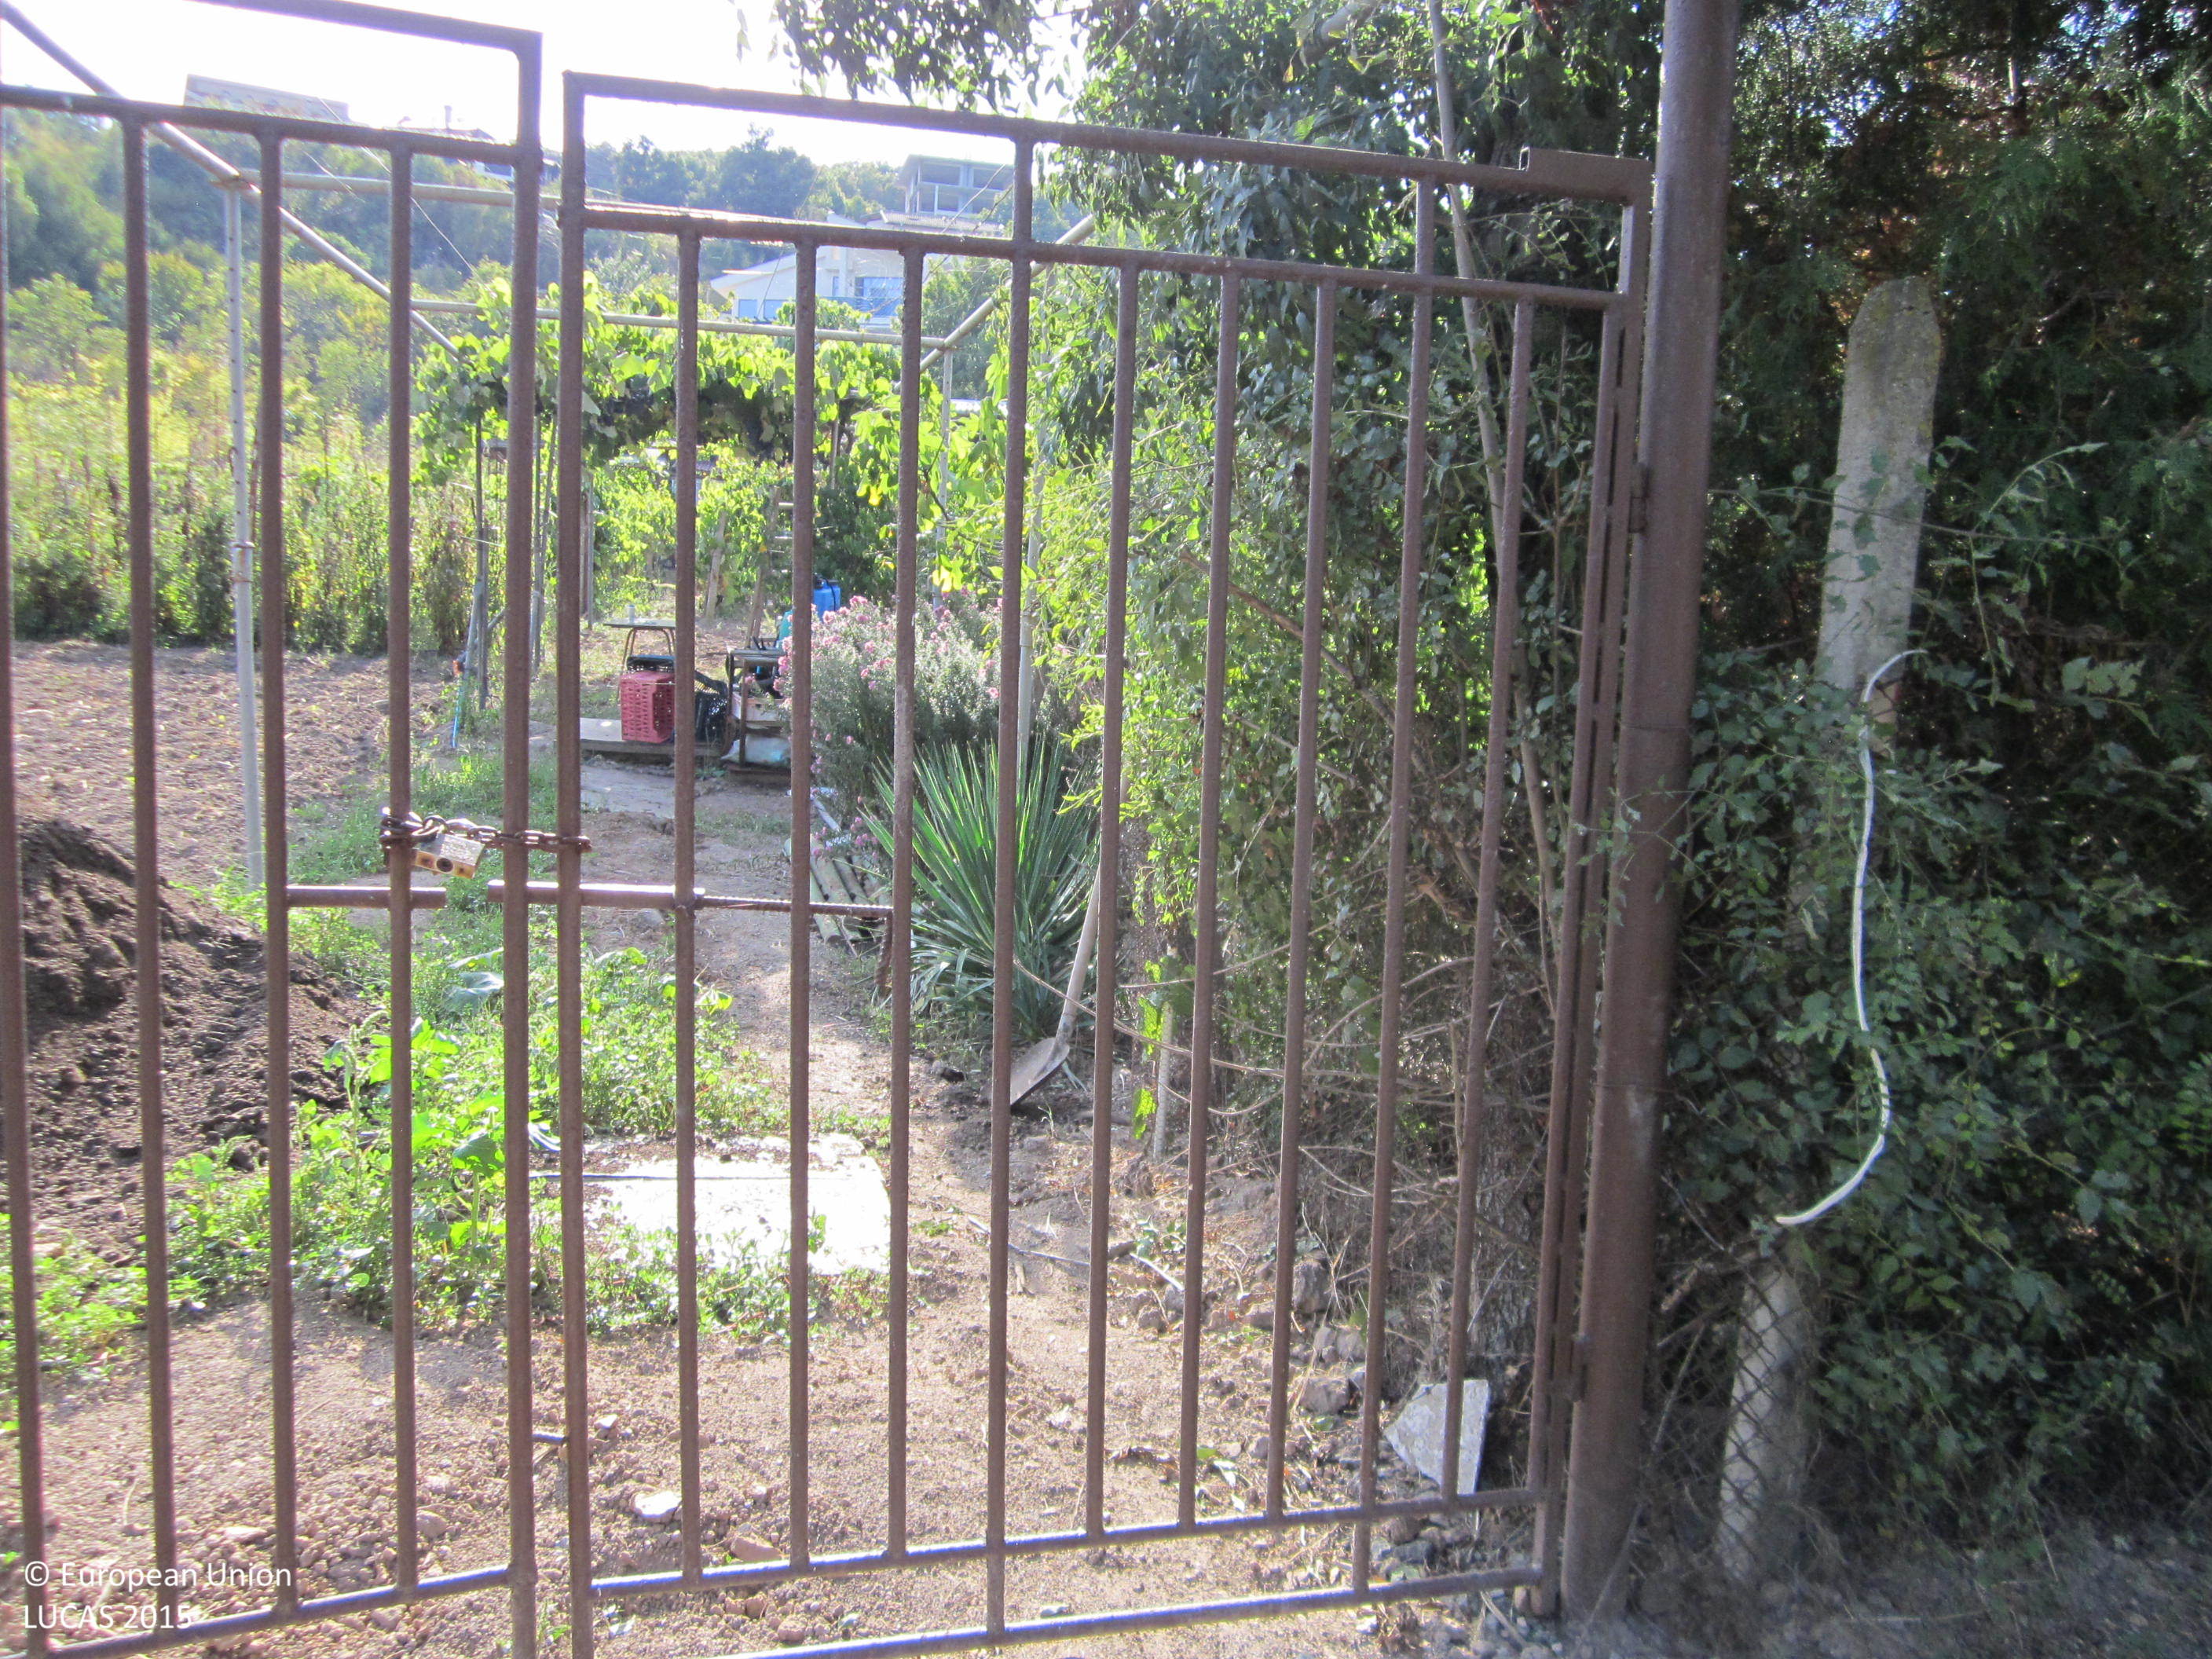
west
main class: Woodland
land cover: Broadleaved woodland
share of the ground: > 75 %
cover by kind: broadleaved forest trees 75 %, shrubs 20 %, herbaceous plants 5 %
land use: Residential
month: September
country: BG
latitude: 42.2725
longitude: 27.7383
